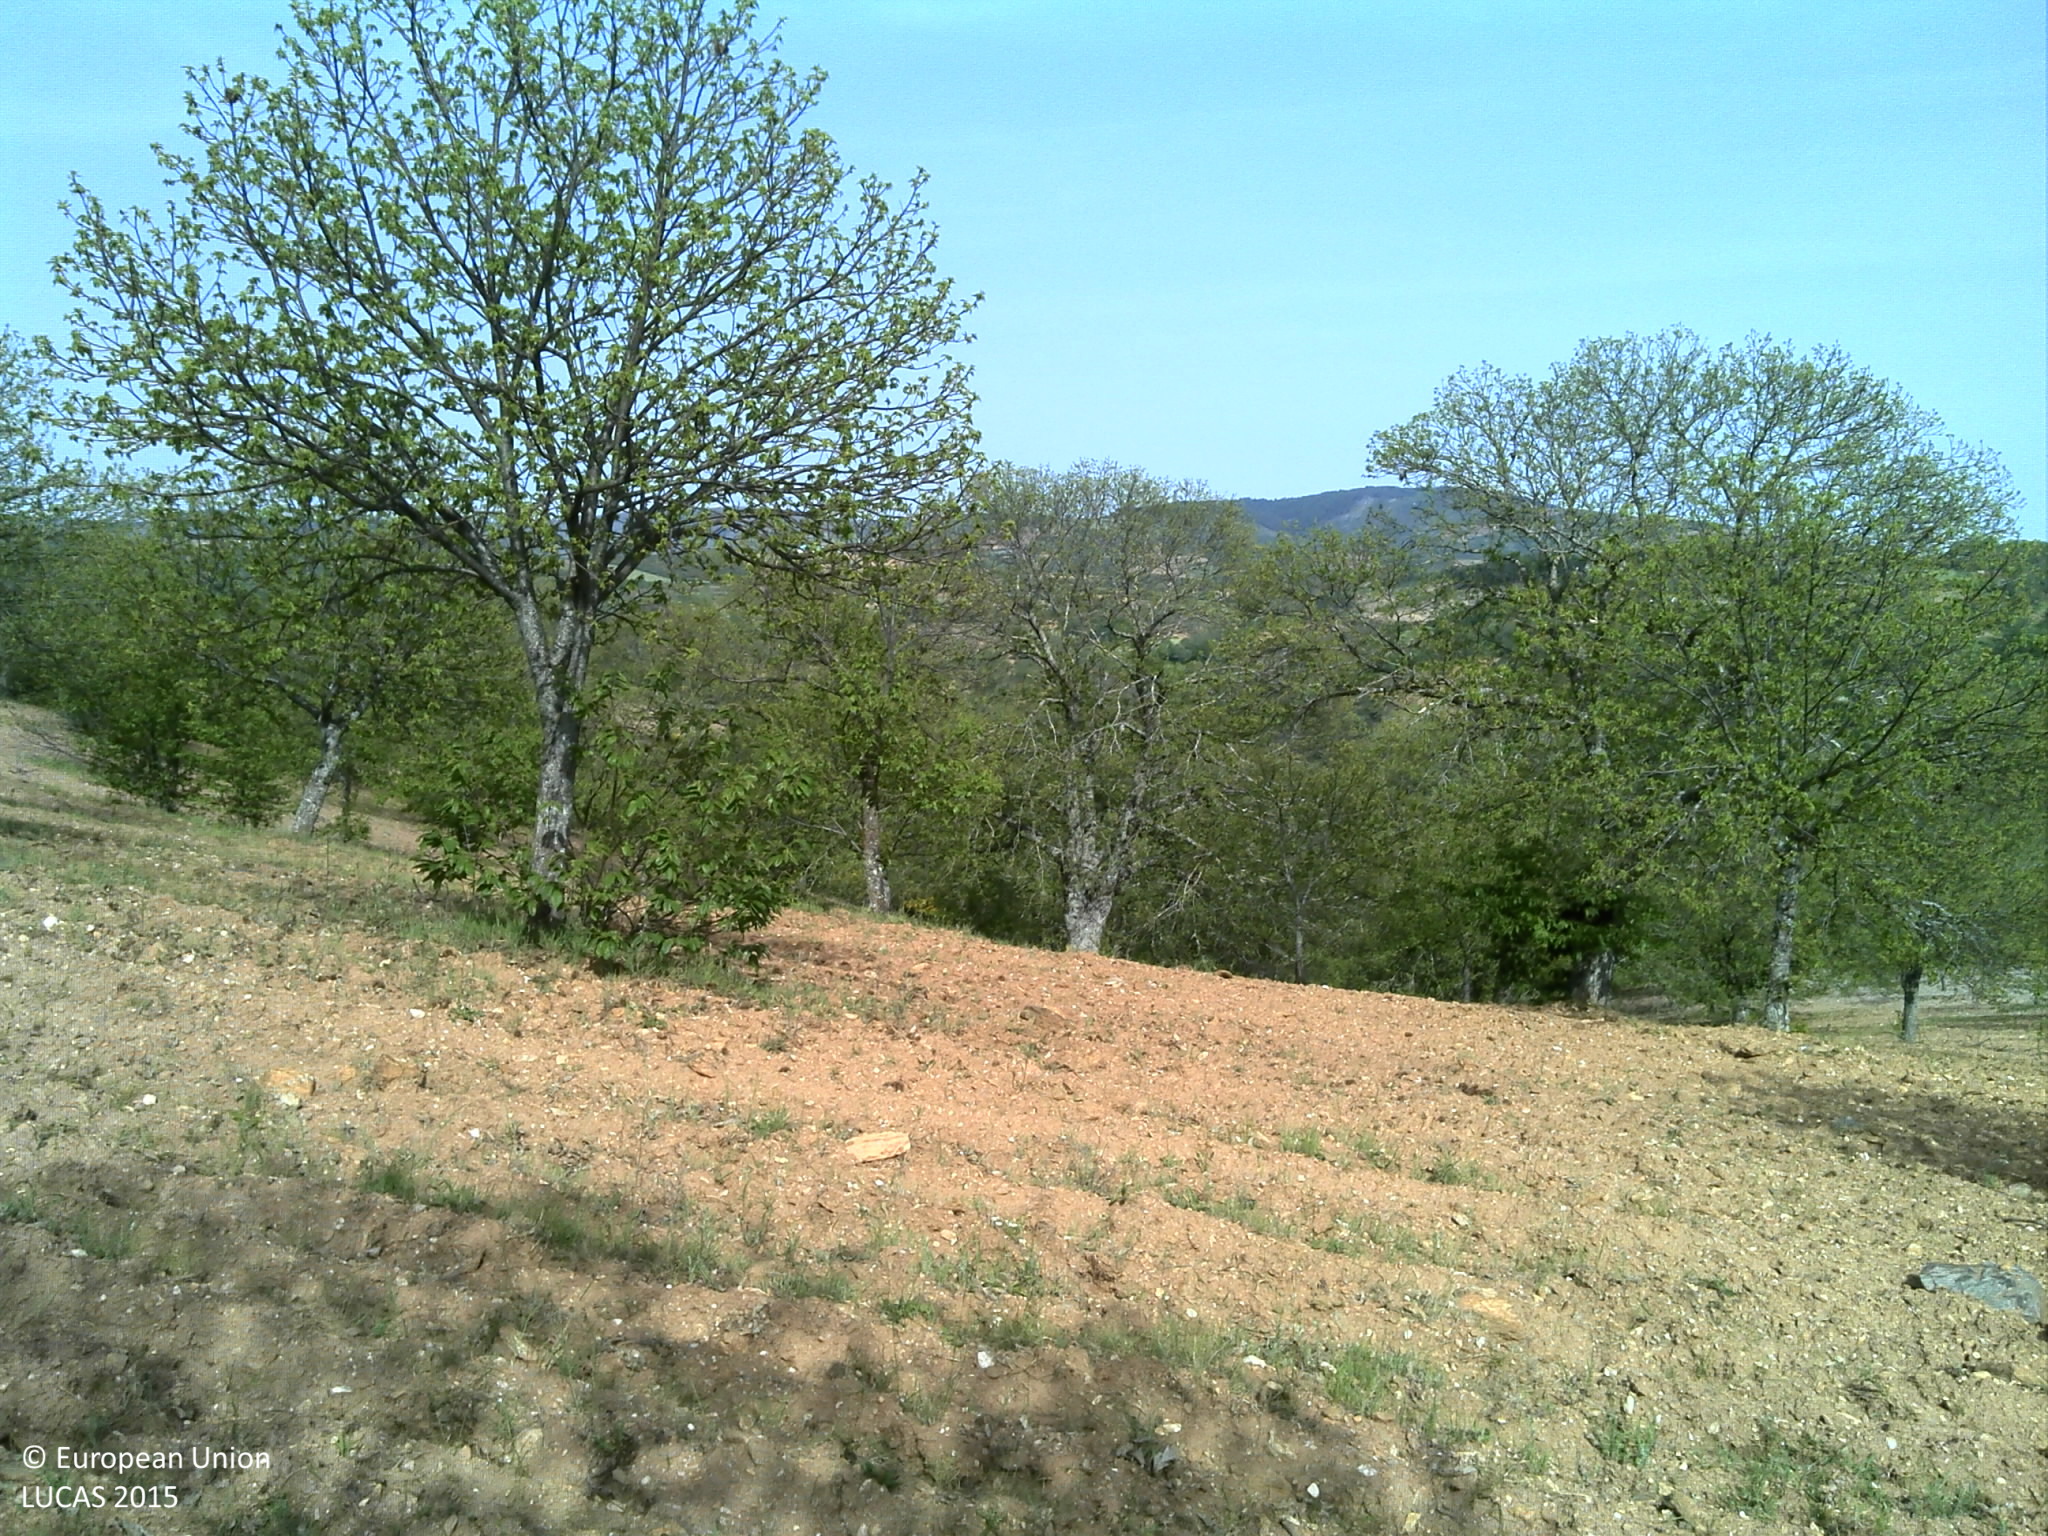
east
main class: Cropland
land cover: Nuts trees
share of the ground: 10 - 25 %
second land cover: Spontaneously vegetated surfaces
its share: 10 - 25 %
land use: Agriculture (excluding fallow land and kitchen gardens)
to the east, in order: Nuts trees; Spontaneously vegetated surfaces; Nuts trees; Shrubland without tree cover; Nuts trees
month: May
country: PT
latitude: 41.7096
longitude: -6.9542
